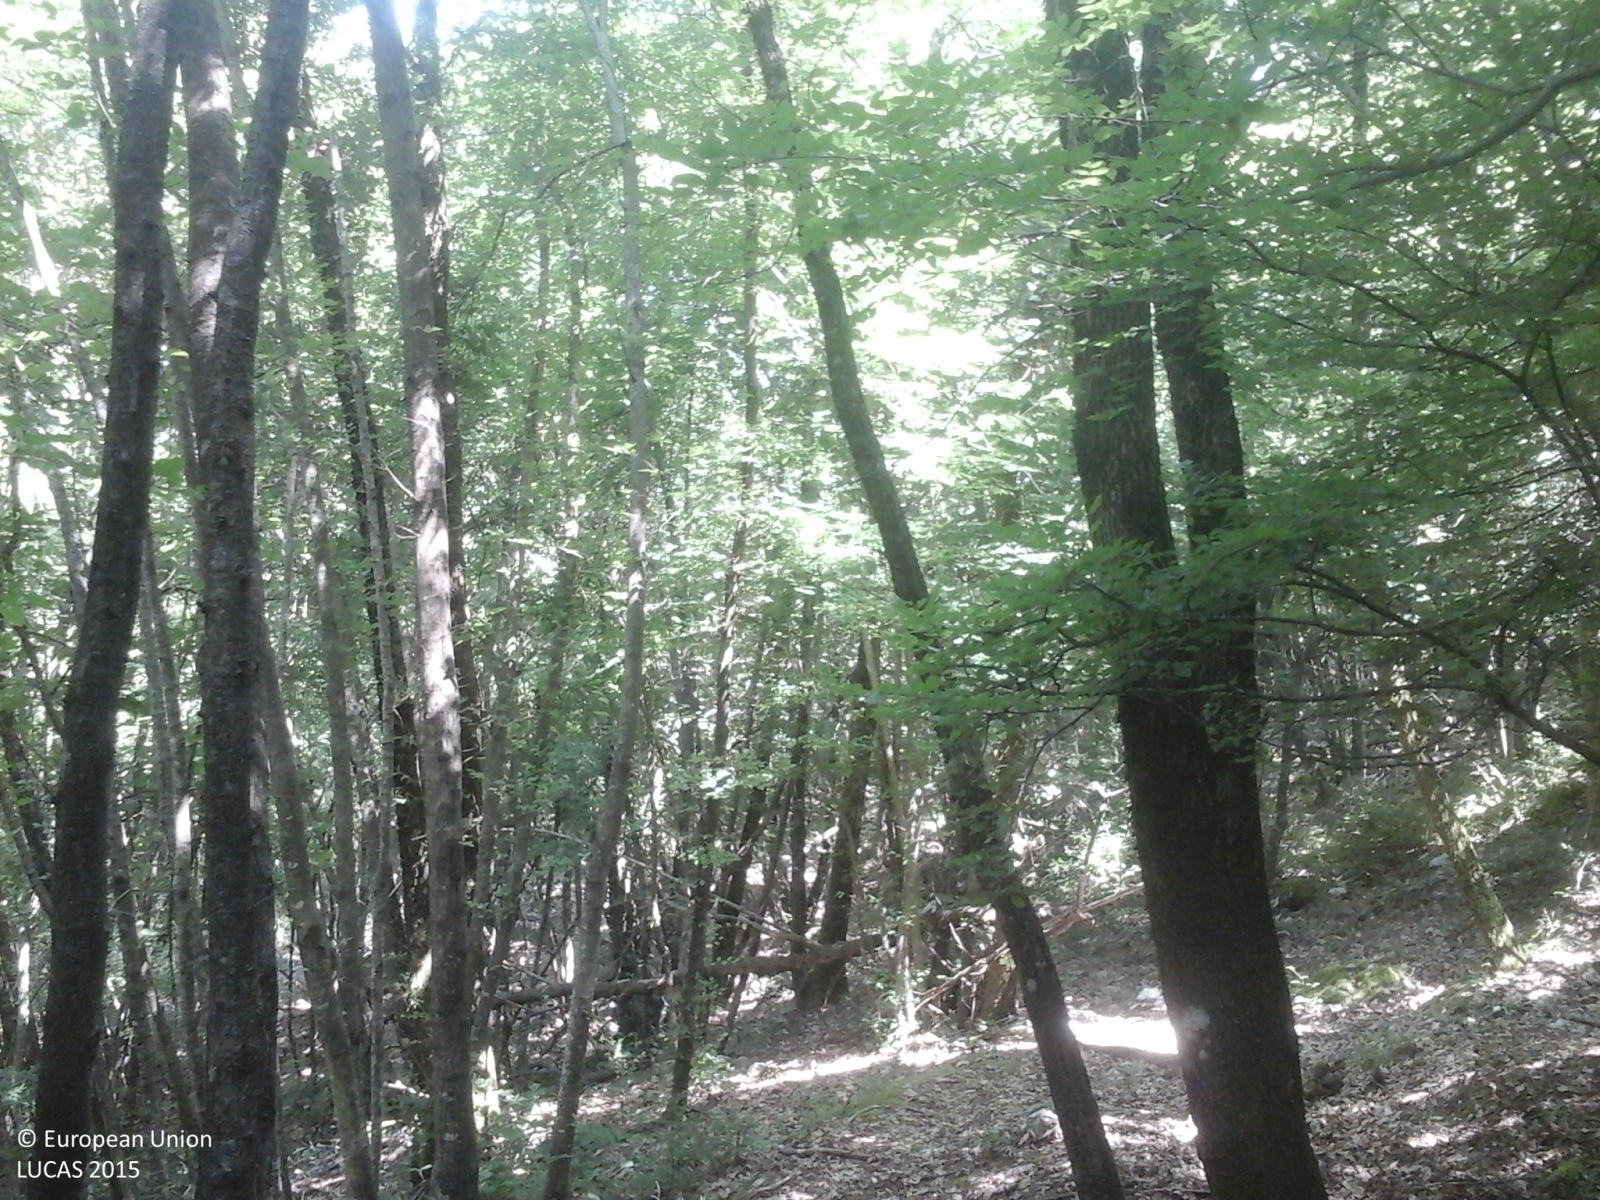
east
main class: Woodland
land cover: Broadleaved woodland
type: thermophilous deciduous forest
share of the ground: > 75 %
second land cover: Grassland without tree/shrub cover
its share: > 75 %
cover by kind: broadleaved forest trees 95 %, herbaceous plants 5 %
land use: Forestry
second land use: Agriculture (excluding fallow land and kitchen gardens)
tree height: > 5 m
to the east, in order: Broadleaved woodland; Grassland without tree/shrub cover; Fences; Grassland without tree/shrub cover; Rock outcrops; Broadleaved woodland
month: June
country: IT
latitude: 41.5543
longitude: 13.2127
